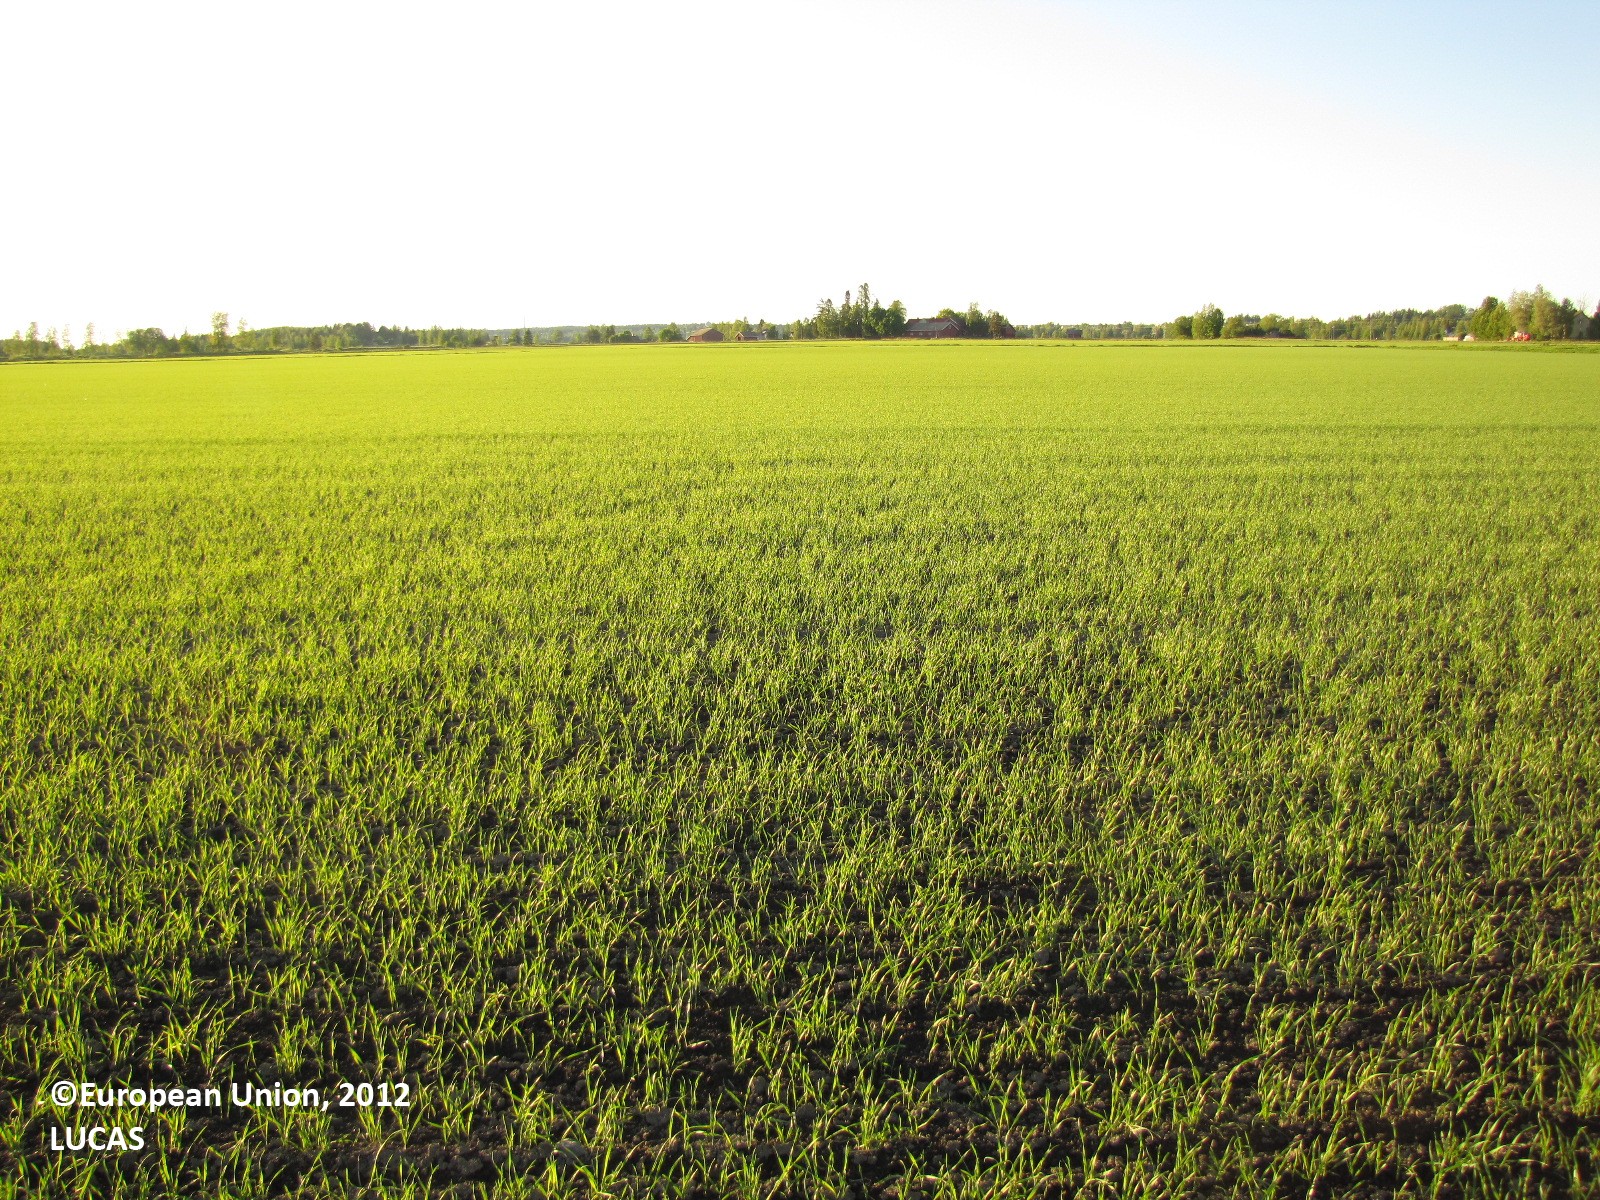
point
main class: Cropland
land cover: Common wheat
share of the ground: 25 - 50 %
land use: Agriculture (excluding fallow land and kitchen gardens)
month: June
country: FI
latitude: 61.3220
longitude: 22.9041
